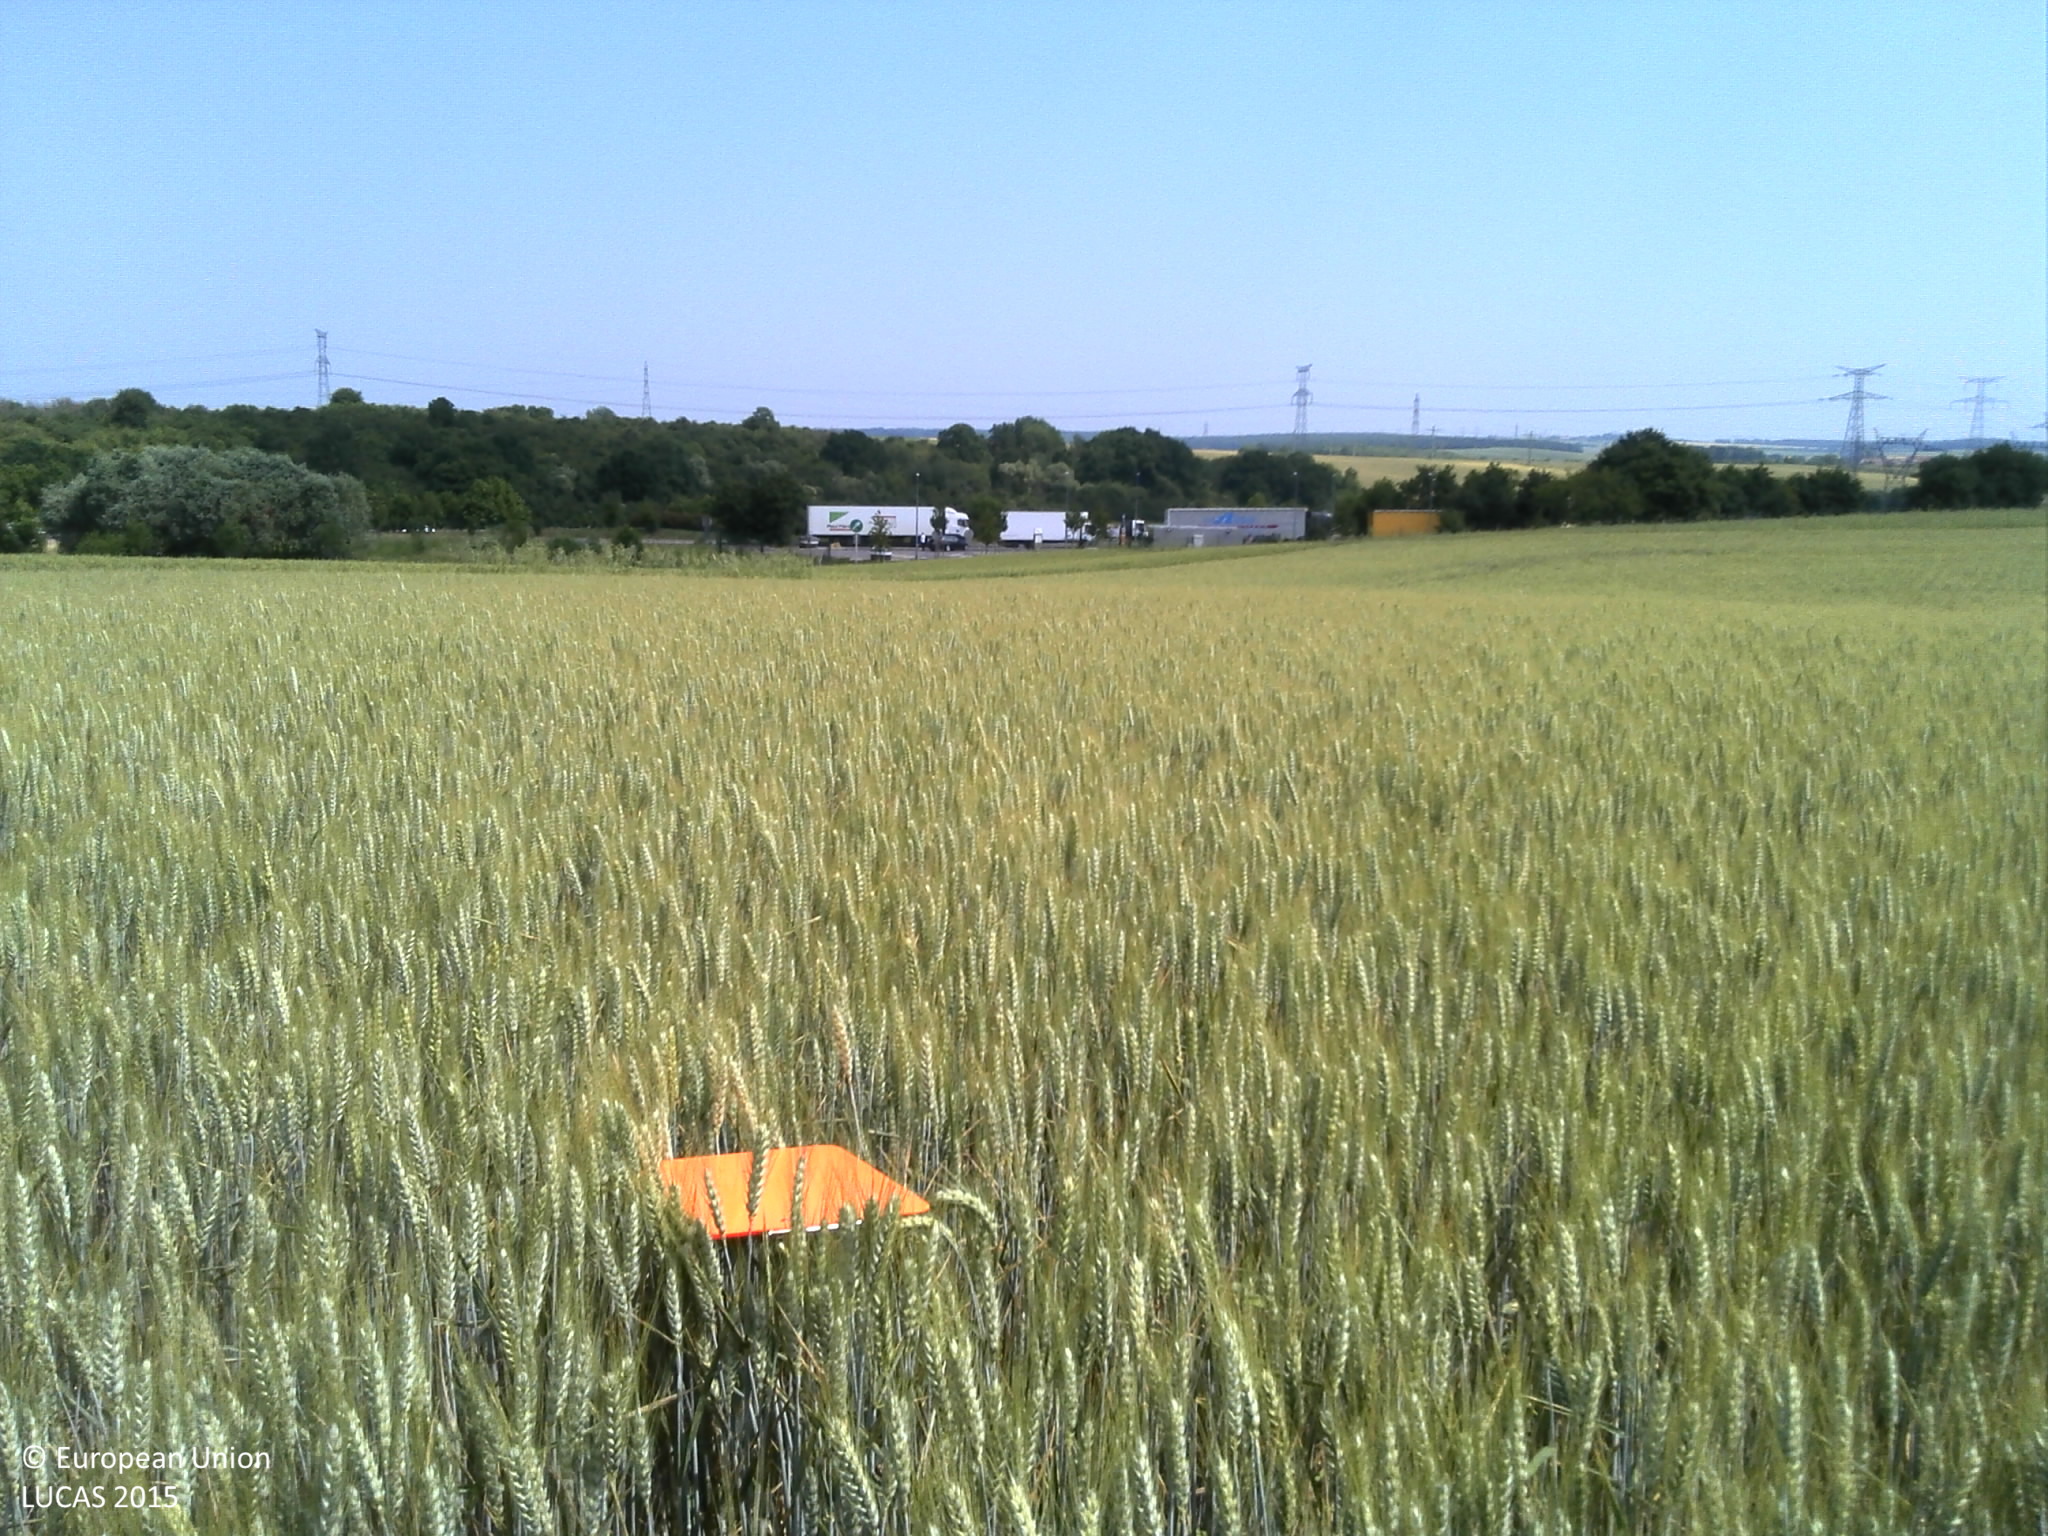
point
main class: Cropland
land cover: Common wheat
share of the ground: > 75 %
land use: Agriculture (excluding fallow land and kitchen gardens)
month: June
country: FR
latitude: 49.1856
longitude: 6.2267
